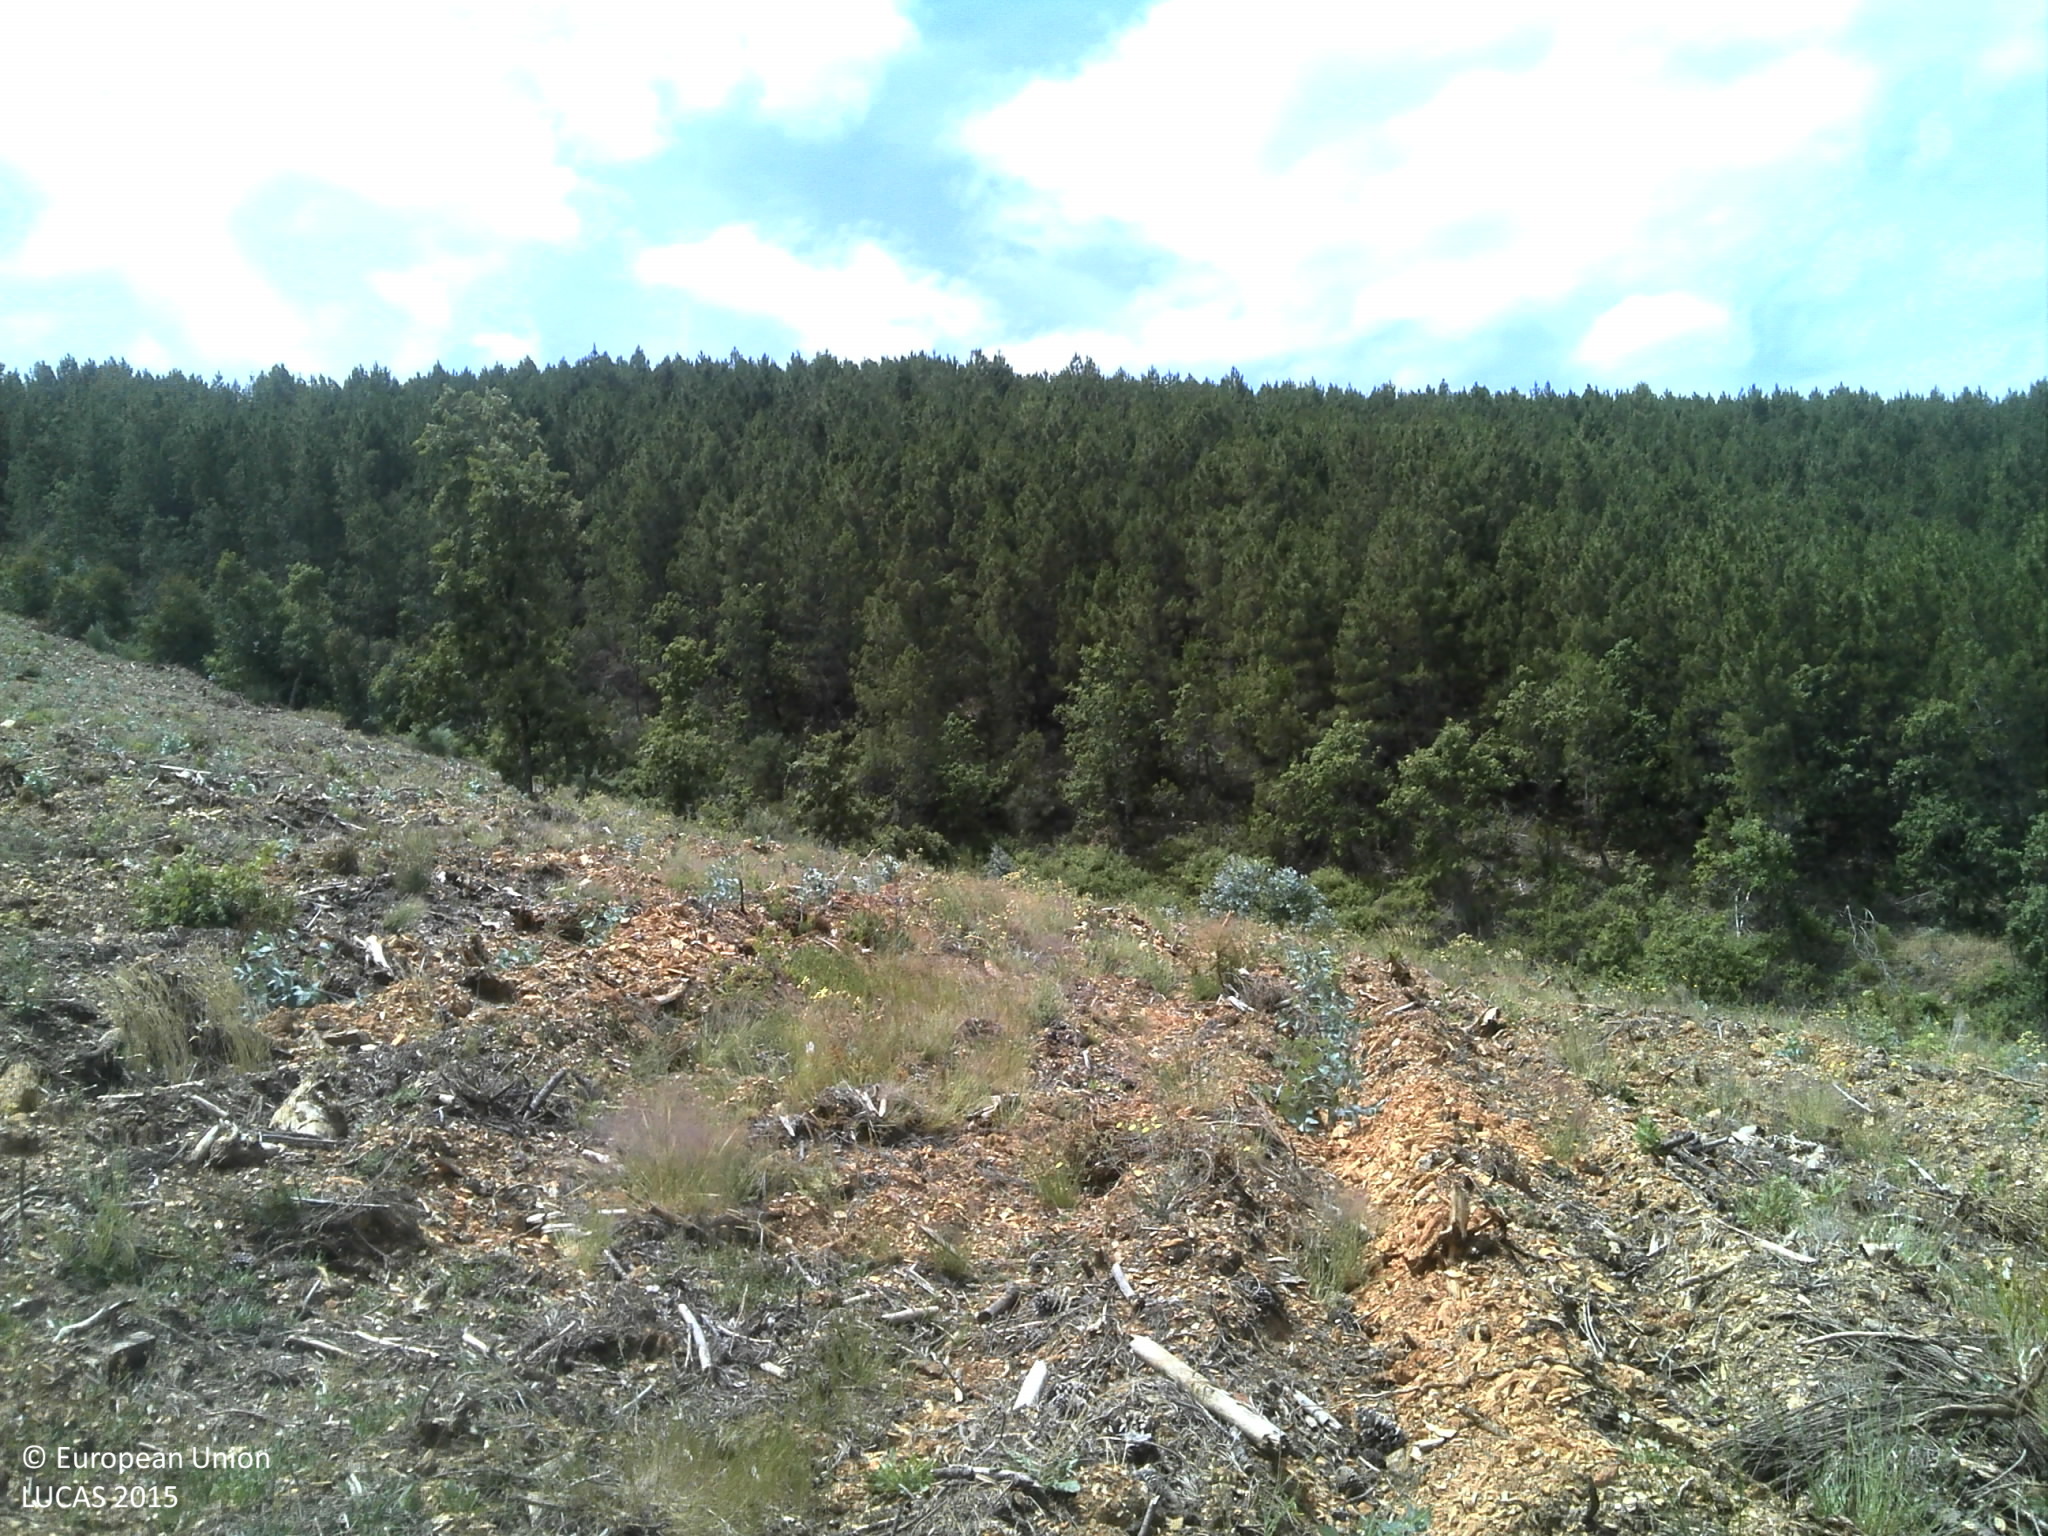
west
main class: Woodland
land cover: Broadleaved woodland
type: exotic forest
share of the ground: < 10 %
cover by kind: unconsolidated bare surface 85 %, broadleaved forest trees 10 %, herbaceous plants 5 %
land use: Forestry
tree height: < 5 m
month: June
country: PT
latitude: 40.1617
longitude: -7.3731
